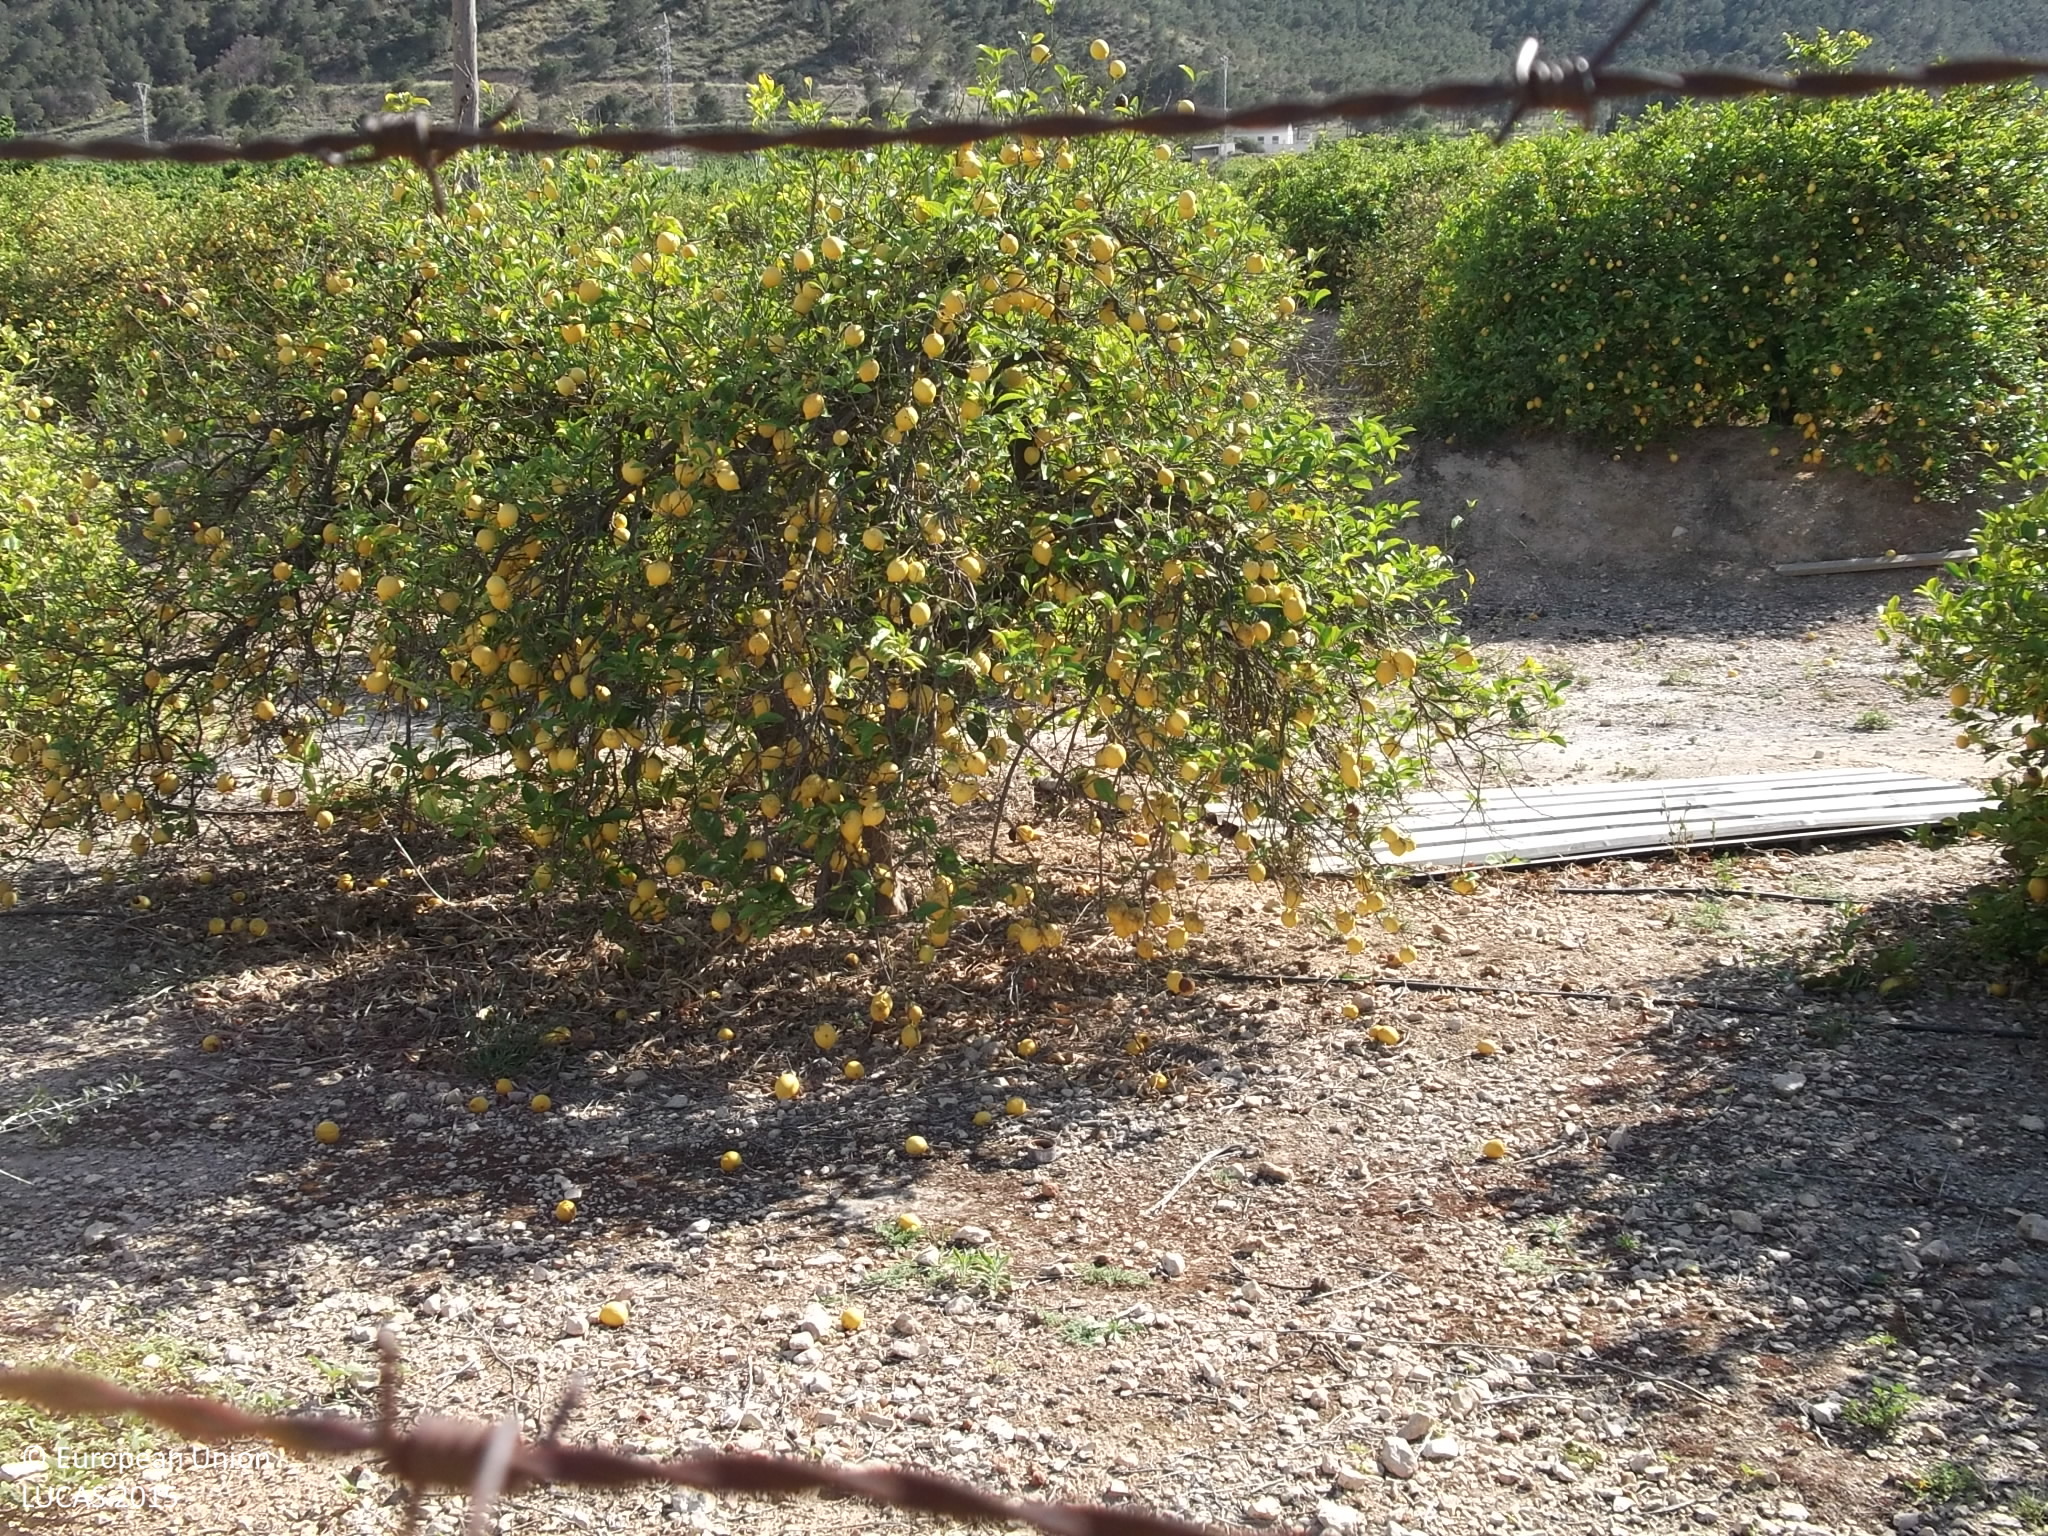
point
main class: Cropland
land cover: Other citrus fruit
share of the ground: 25 - 50 %
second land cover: Spontaneously vegetated surfaces
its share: > 75 %
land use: Agriculture (excluding fallow land and kitchen gardens)
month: April
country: ES
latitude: 38.1846
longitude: -1.3240
